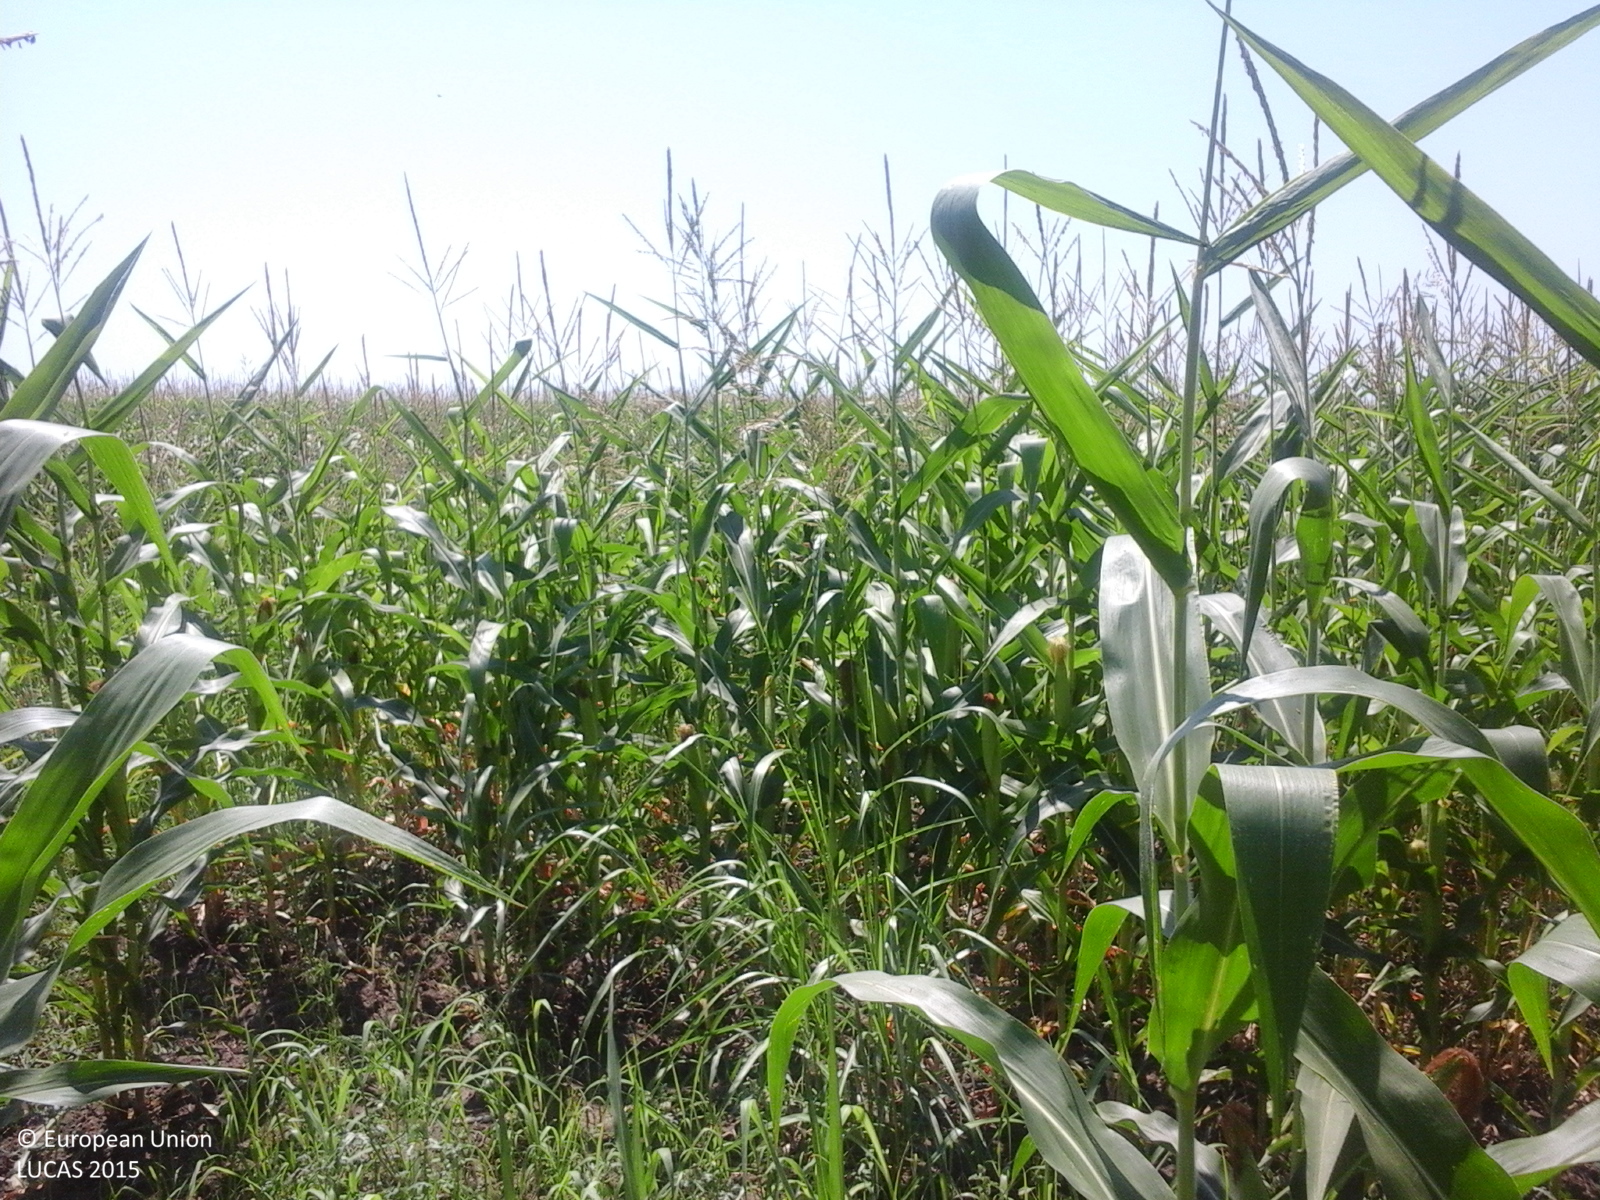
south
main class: Cropland
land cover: Maize
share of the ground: > 75 %
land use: Agriculture (excluding fallow land and kitchen gardens)
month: July
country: RO
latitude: 44.7548
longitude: 26.7876
